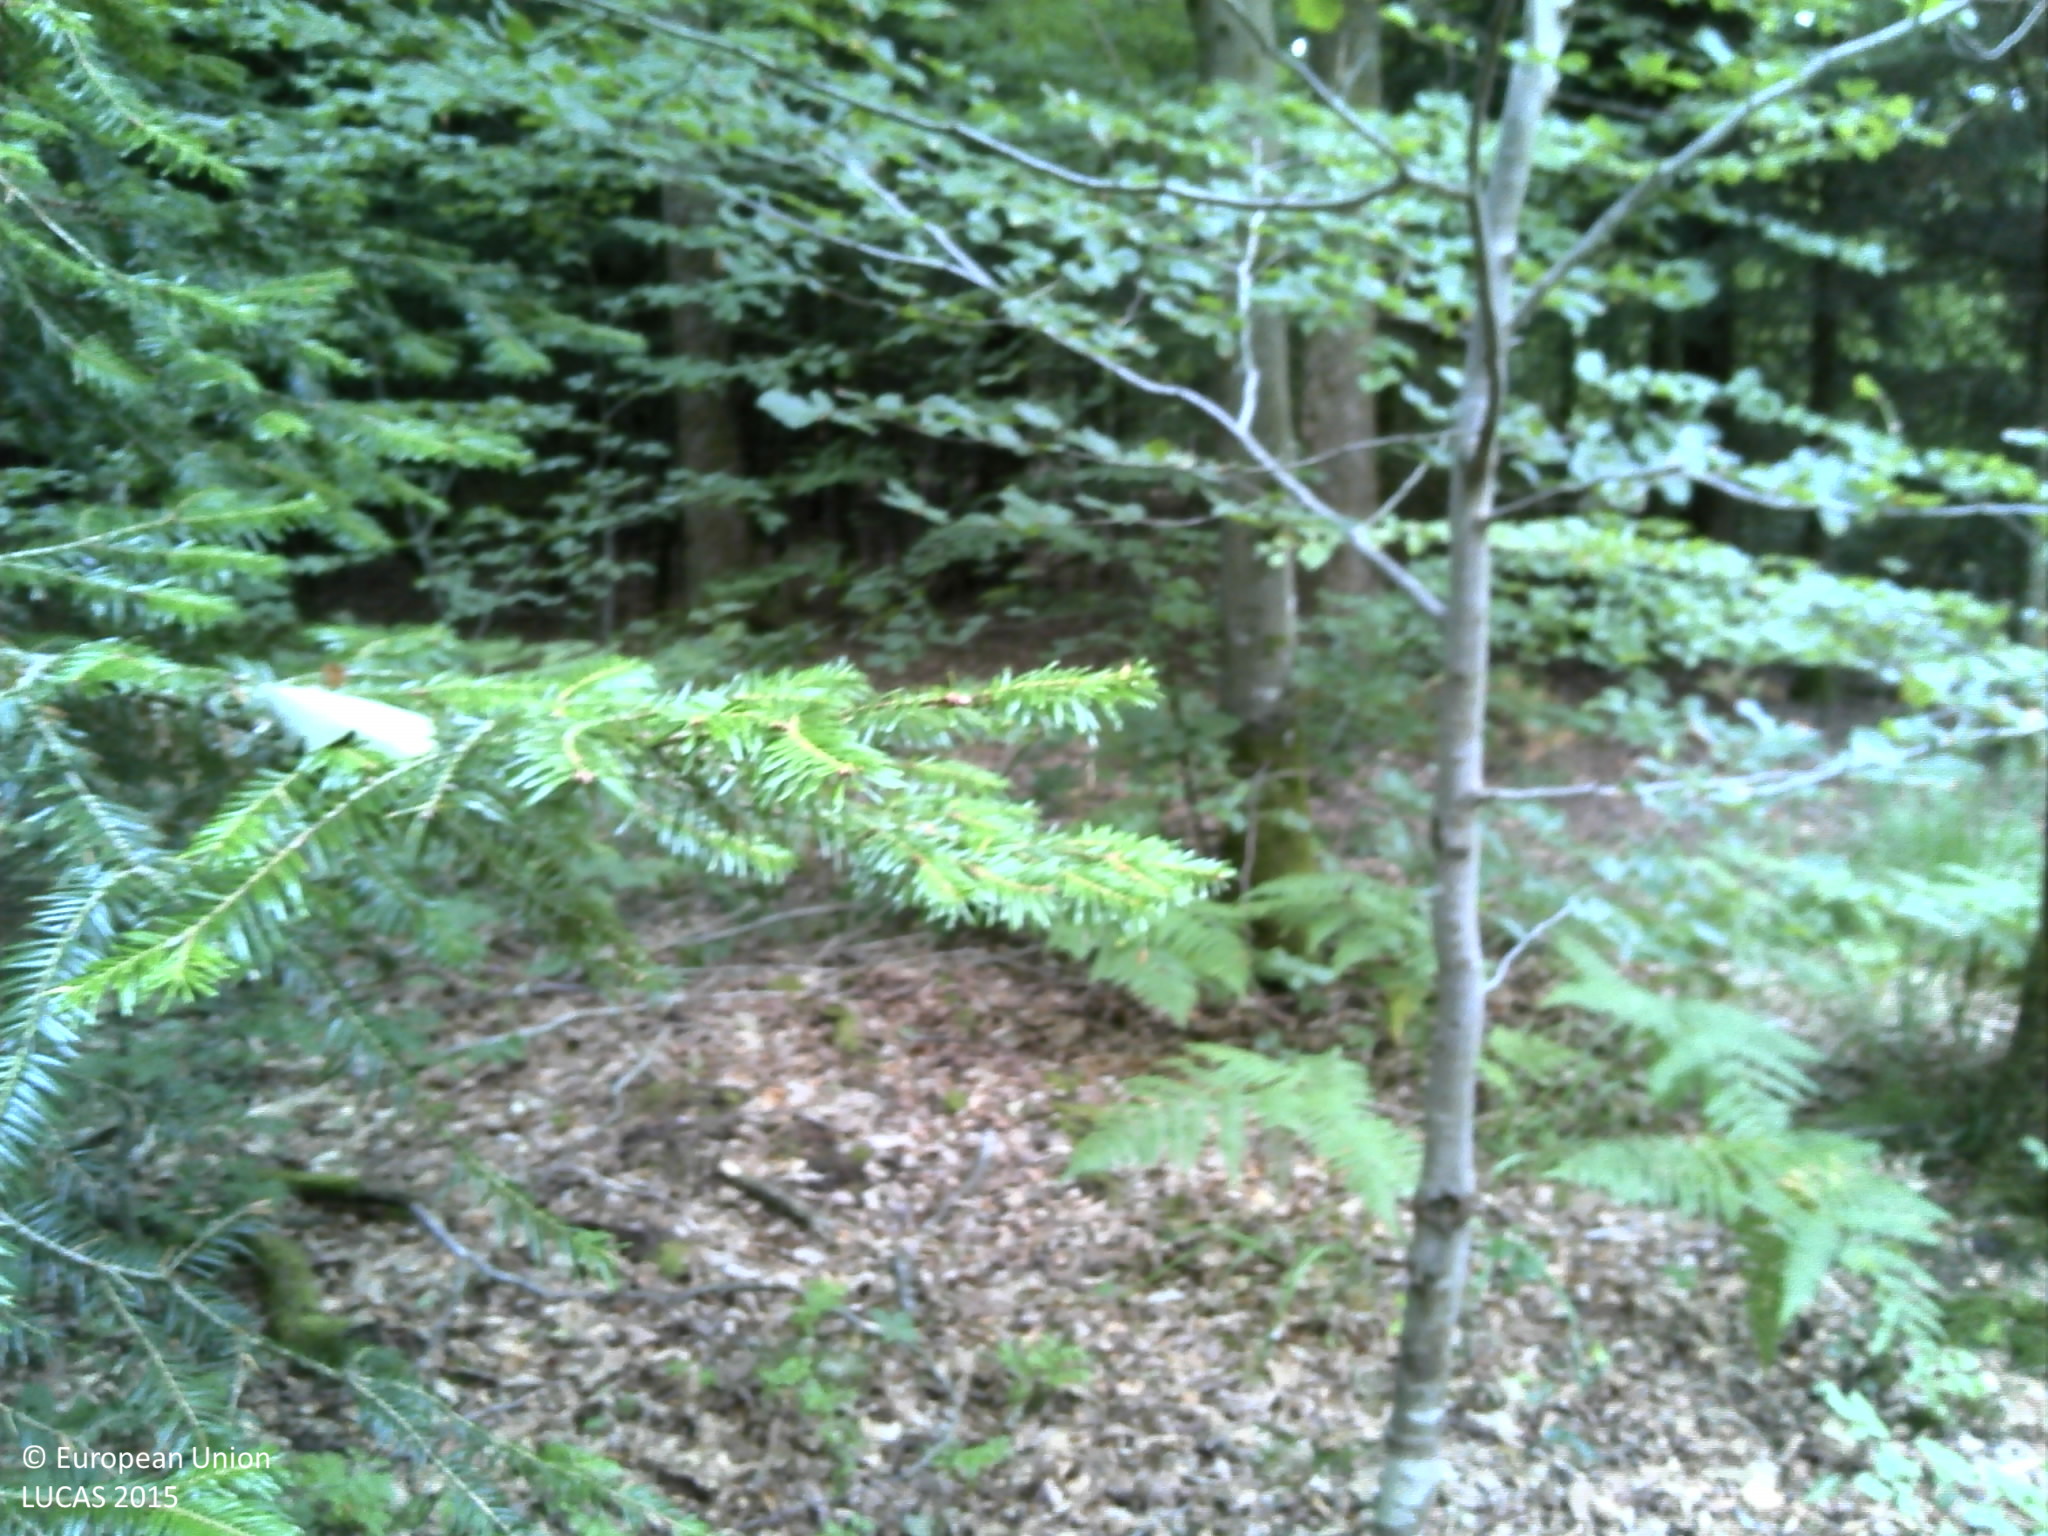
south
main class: Woodland
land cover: Spruce dominated mixed woodland
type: hemiboreal forest and nemoral coniferous forest and mixed broadleaved-coniferous forest
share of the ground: > 75 %
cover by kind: broadleaved forest trees 55 %, coniferous forest trees 40 %, unconsolidated bare surface 5 %
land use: Forestry
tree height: > 5 m
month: August
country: FR
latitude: 48.0804
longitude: 6.5780
